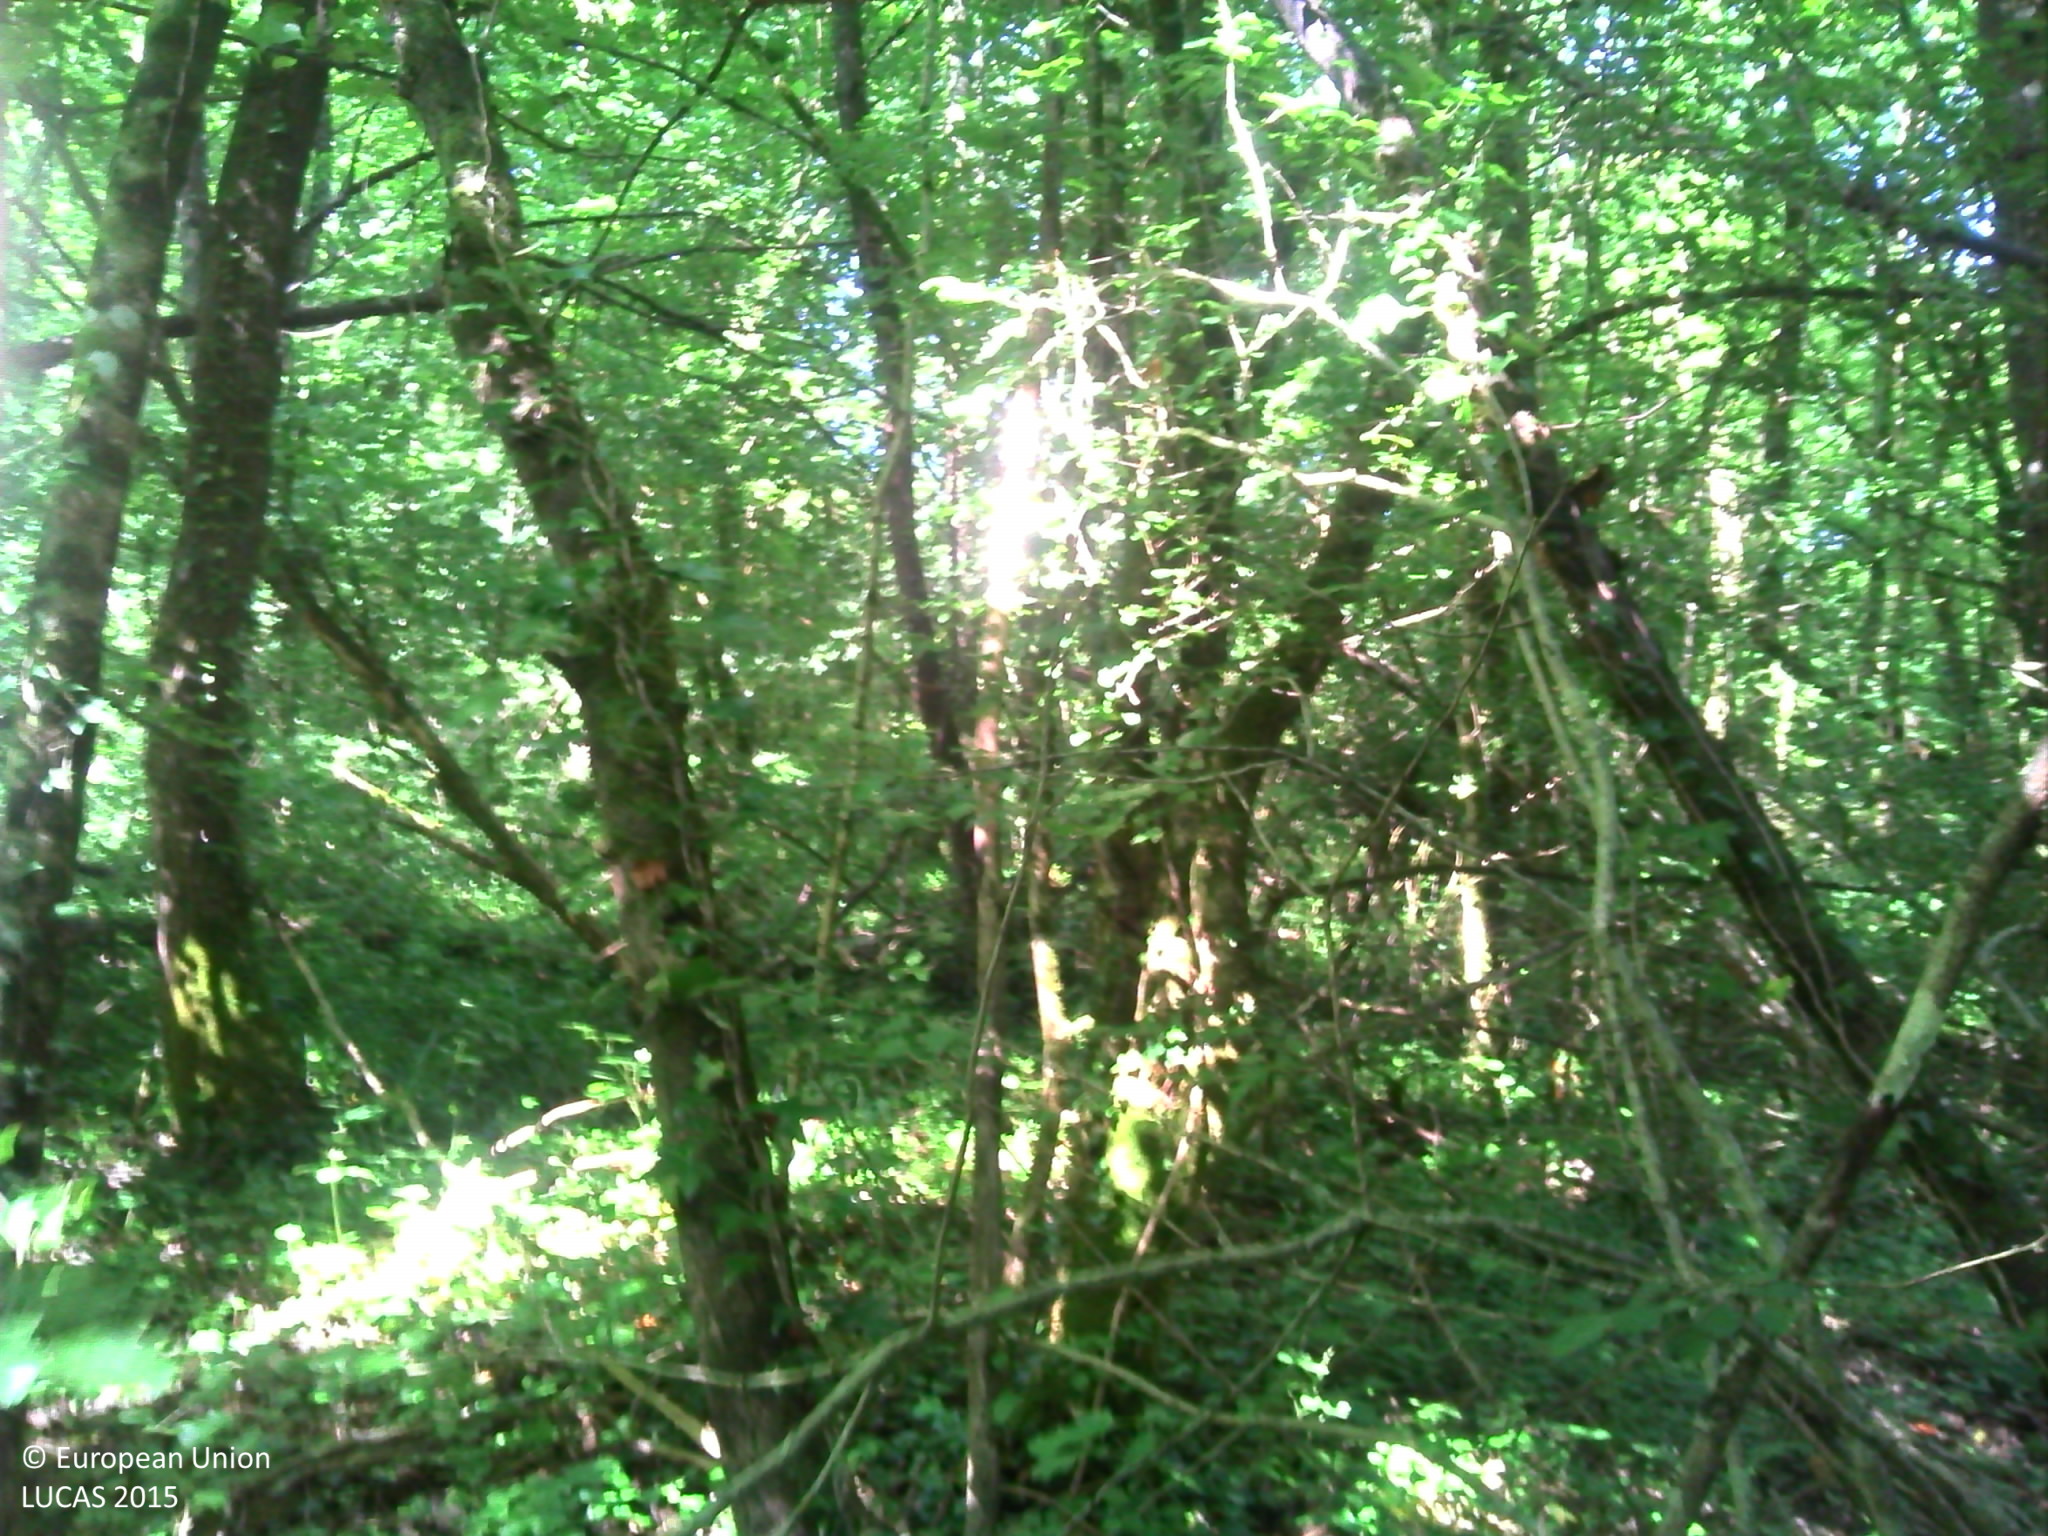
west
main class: Woodland
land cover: Broadleaved woodland
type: beech forest
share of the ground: > 75 %
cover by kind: broadleaved forest trees 85 %, shrubs 10 %, herbaceous plants 5 %
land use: Forestry
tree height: > 5 m
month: June
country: FR
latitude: 47.4796
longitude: 5.4226
